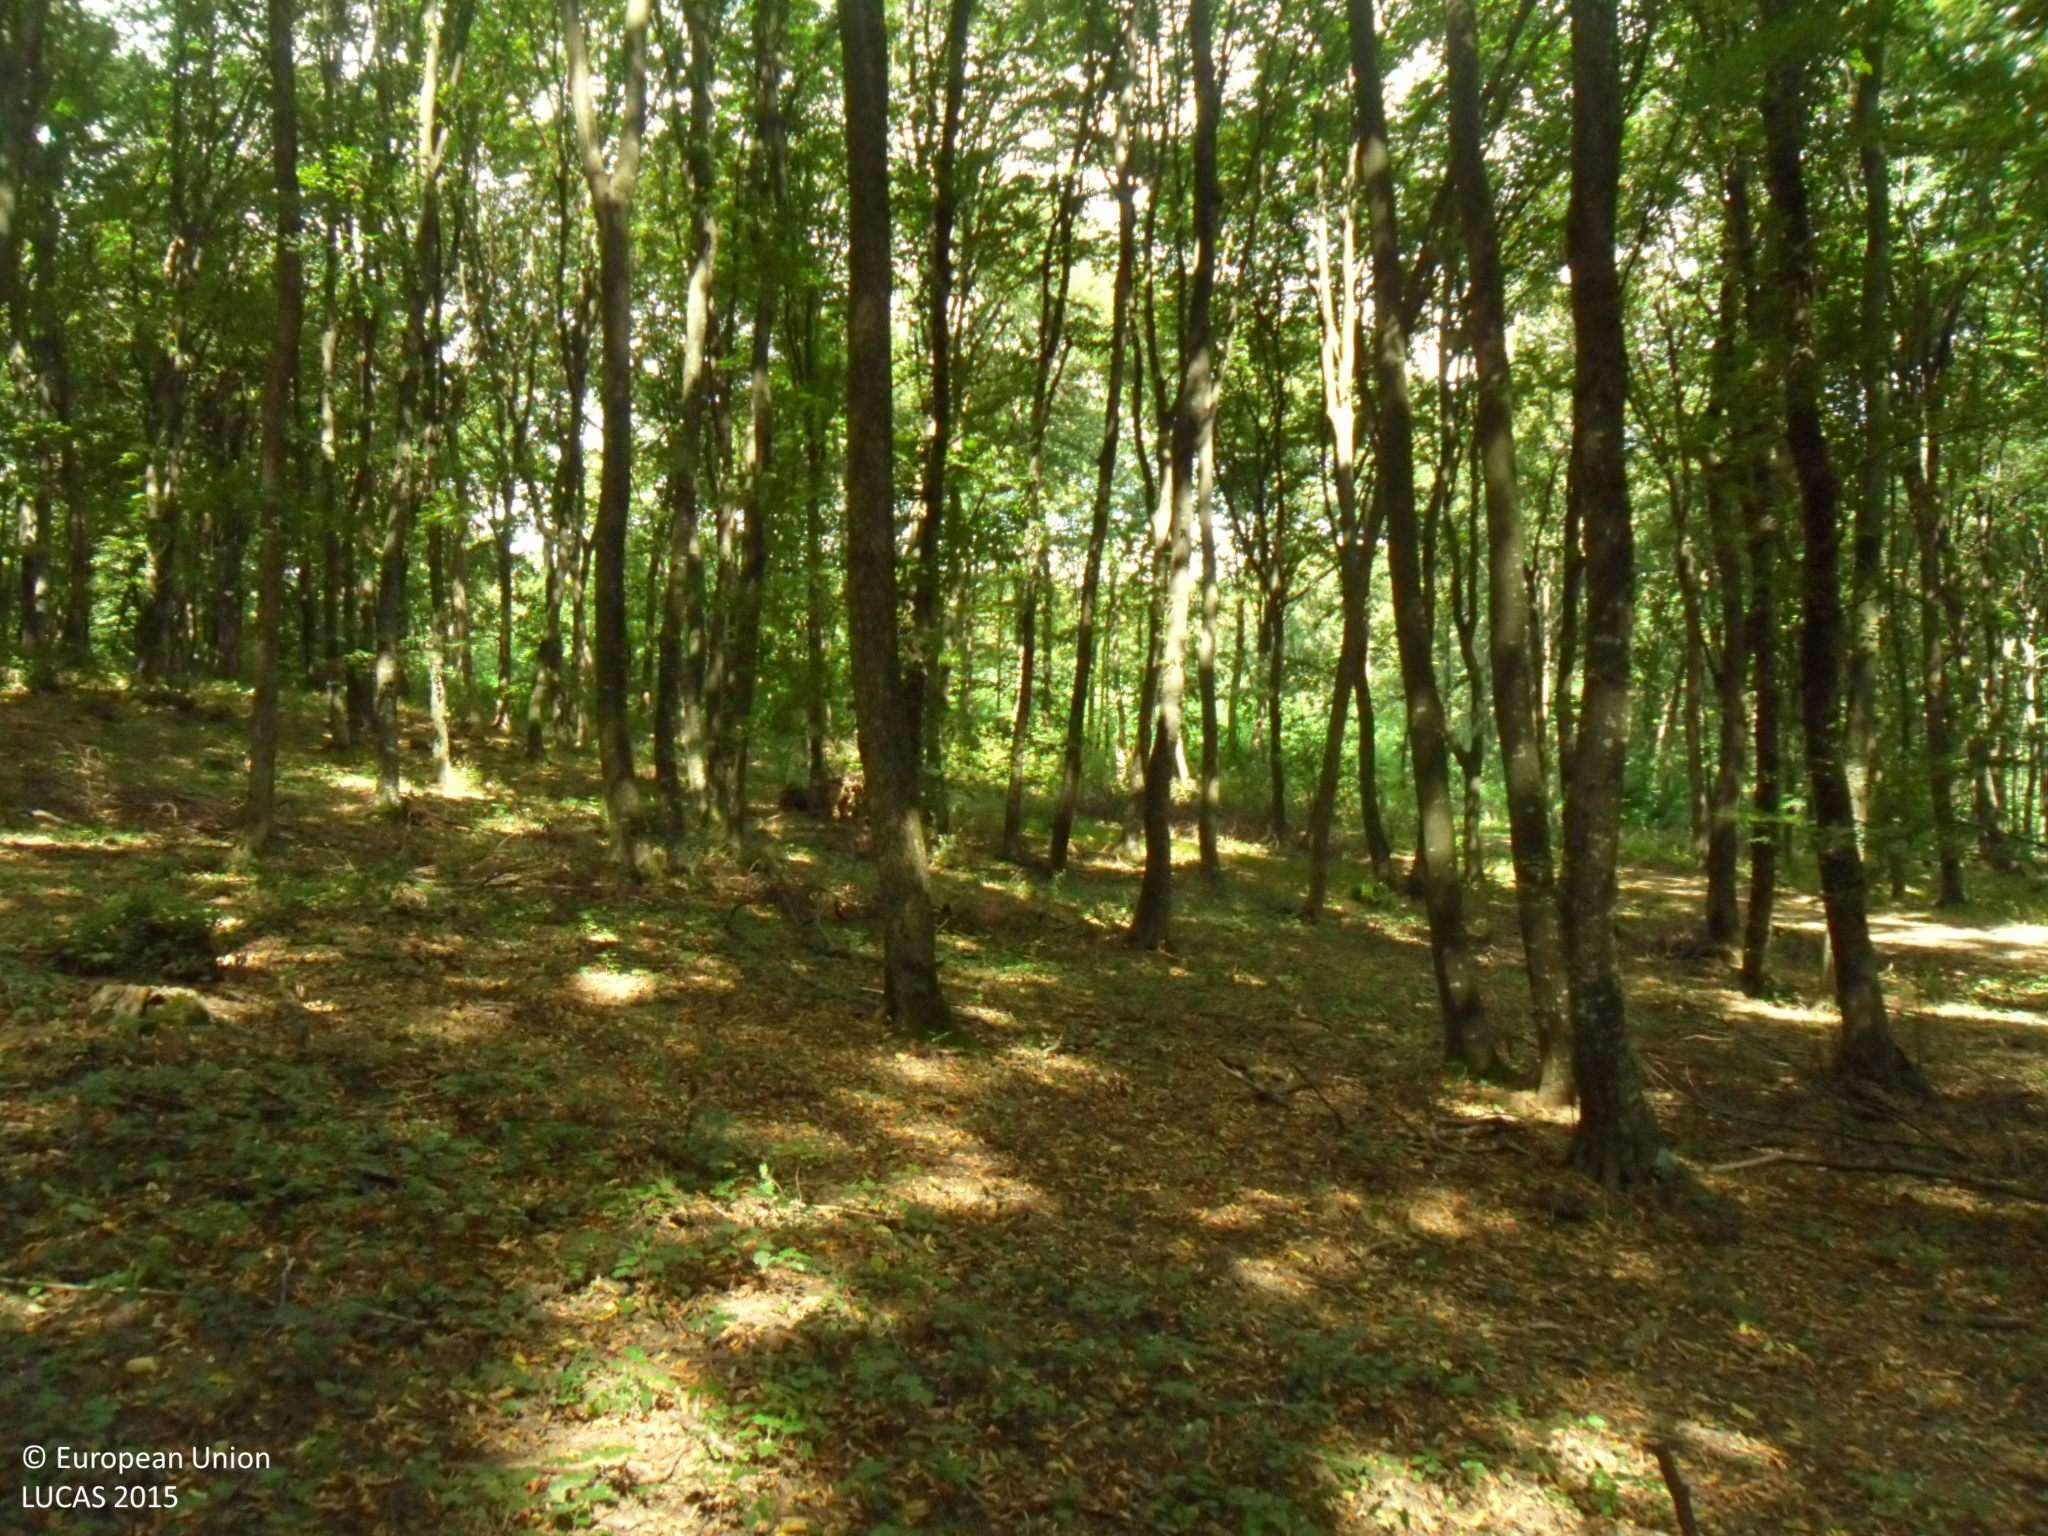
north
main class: Woodland
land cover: Broadleaved woodland
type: beech forest
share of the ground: > 75 %
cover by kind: broadleaved forest trees 100 %
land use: Forestry
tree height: > 5 m
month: September
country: BG
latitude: 43.5684
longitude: 26.2827
